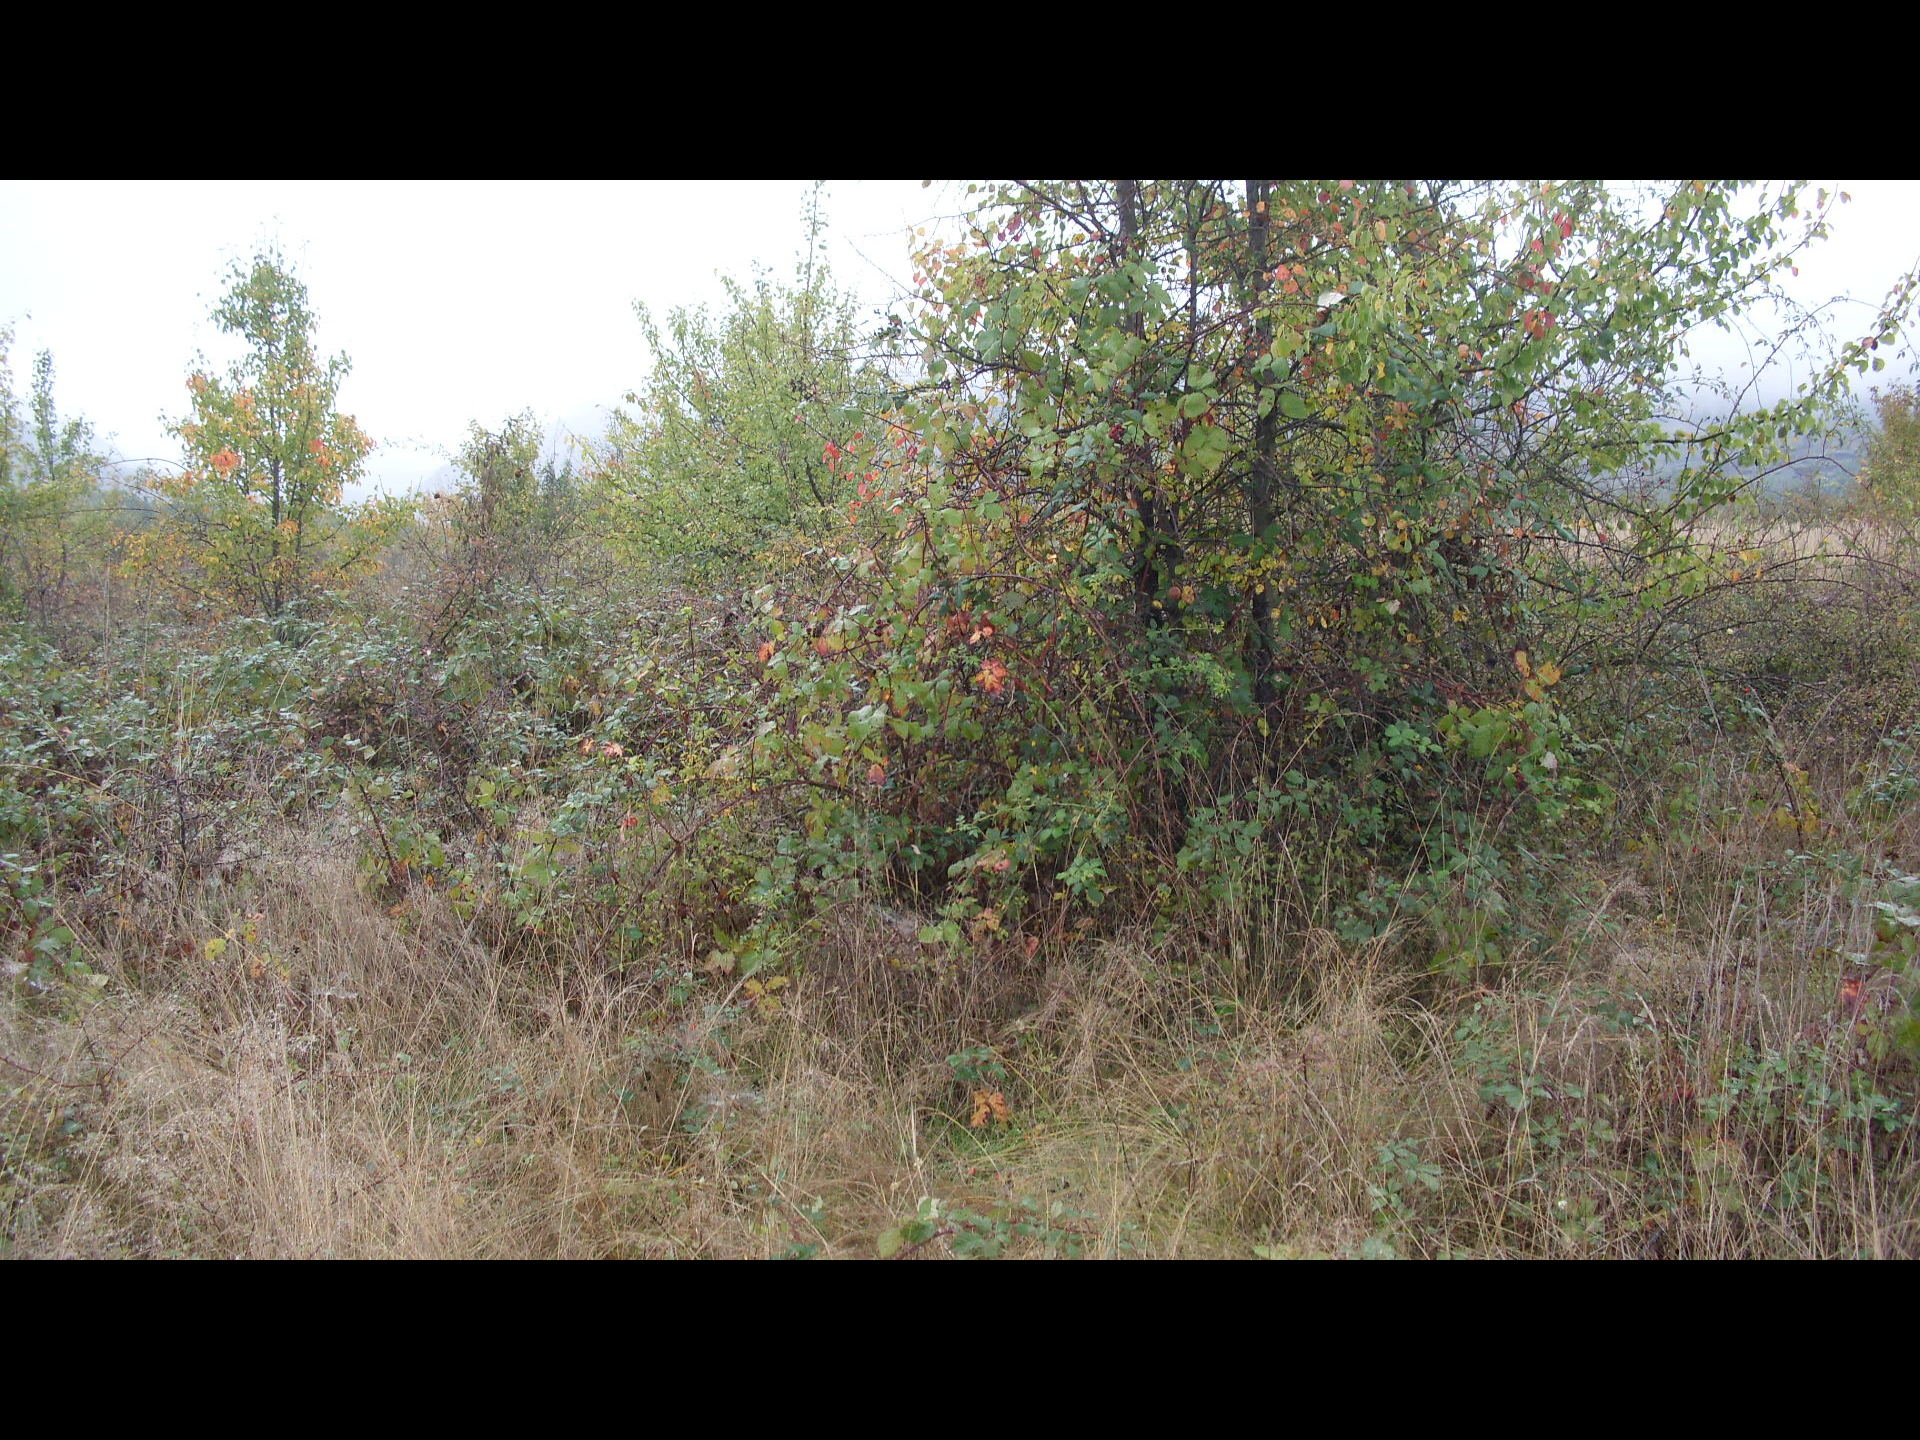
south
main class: Shrubland
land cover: Shrubland with sparse tree cover
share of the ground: > 75 %
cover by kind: shrubs 90 %, broadleaved forest trees 5 %, herbaceous plants 5 %
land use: Semi-natural and natural areas not in use
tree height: < 5 m
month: October
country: BG
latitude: 43.5429
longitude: 22.7444
